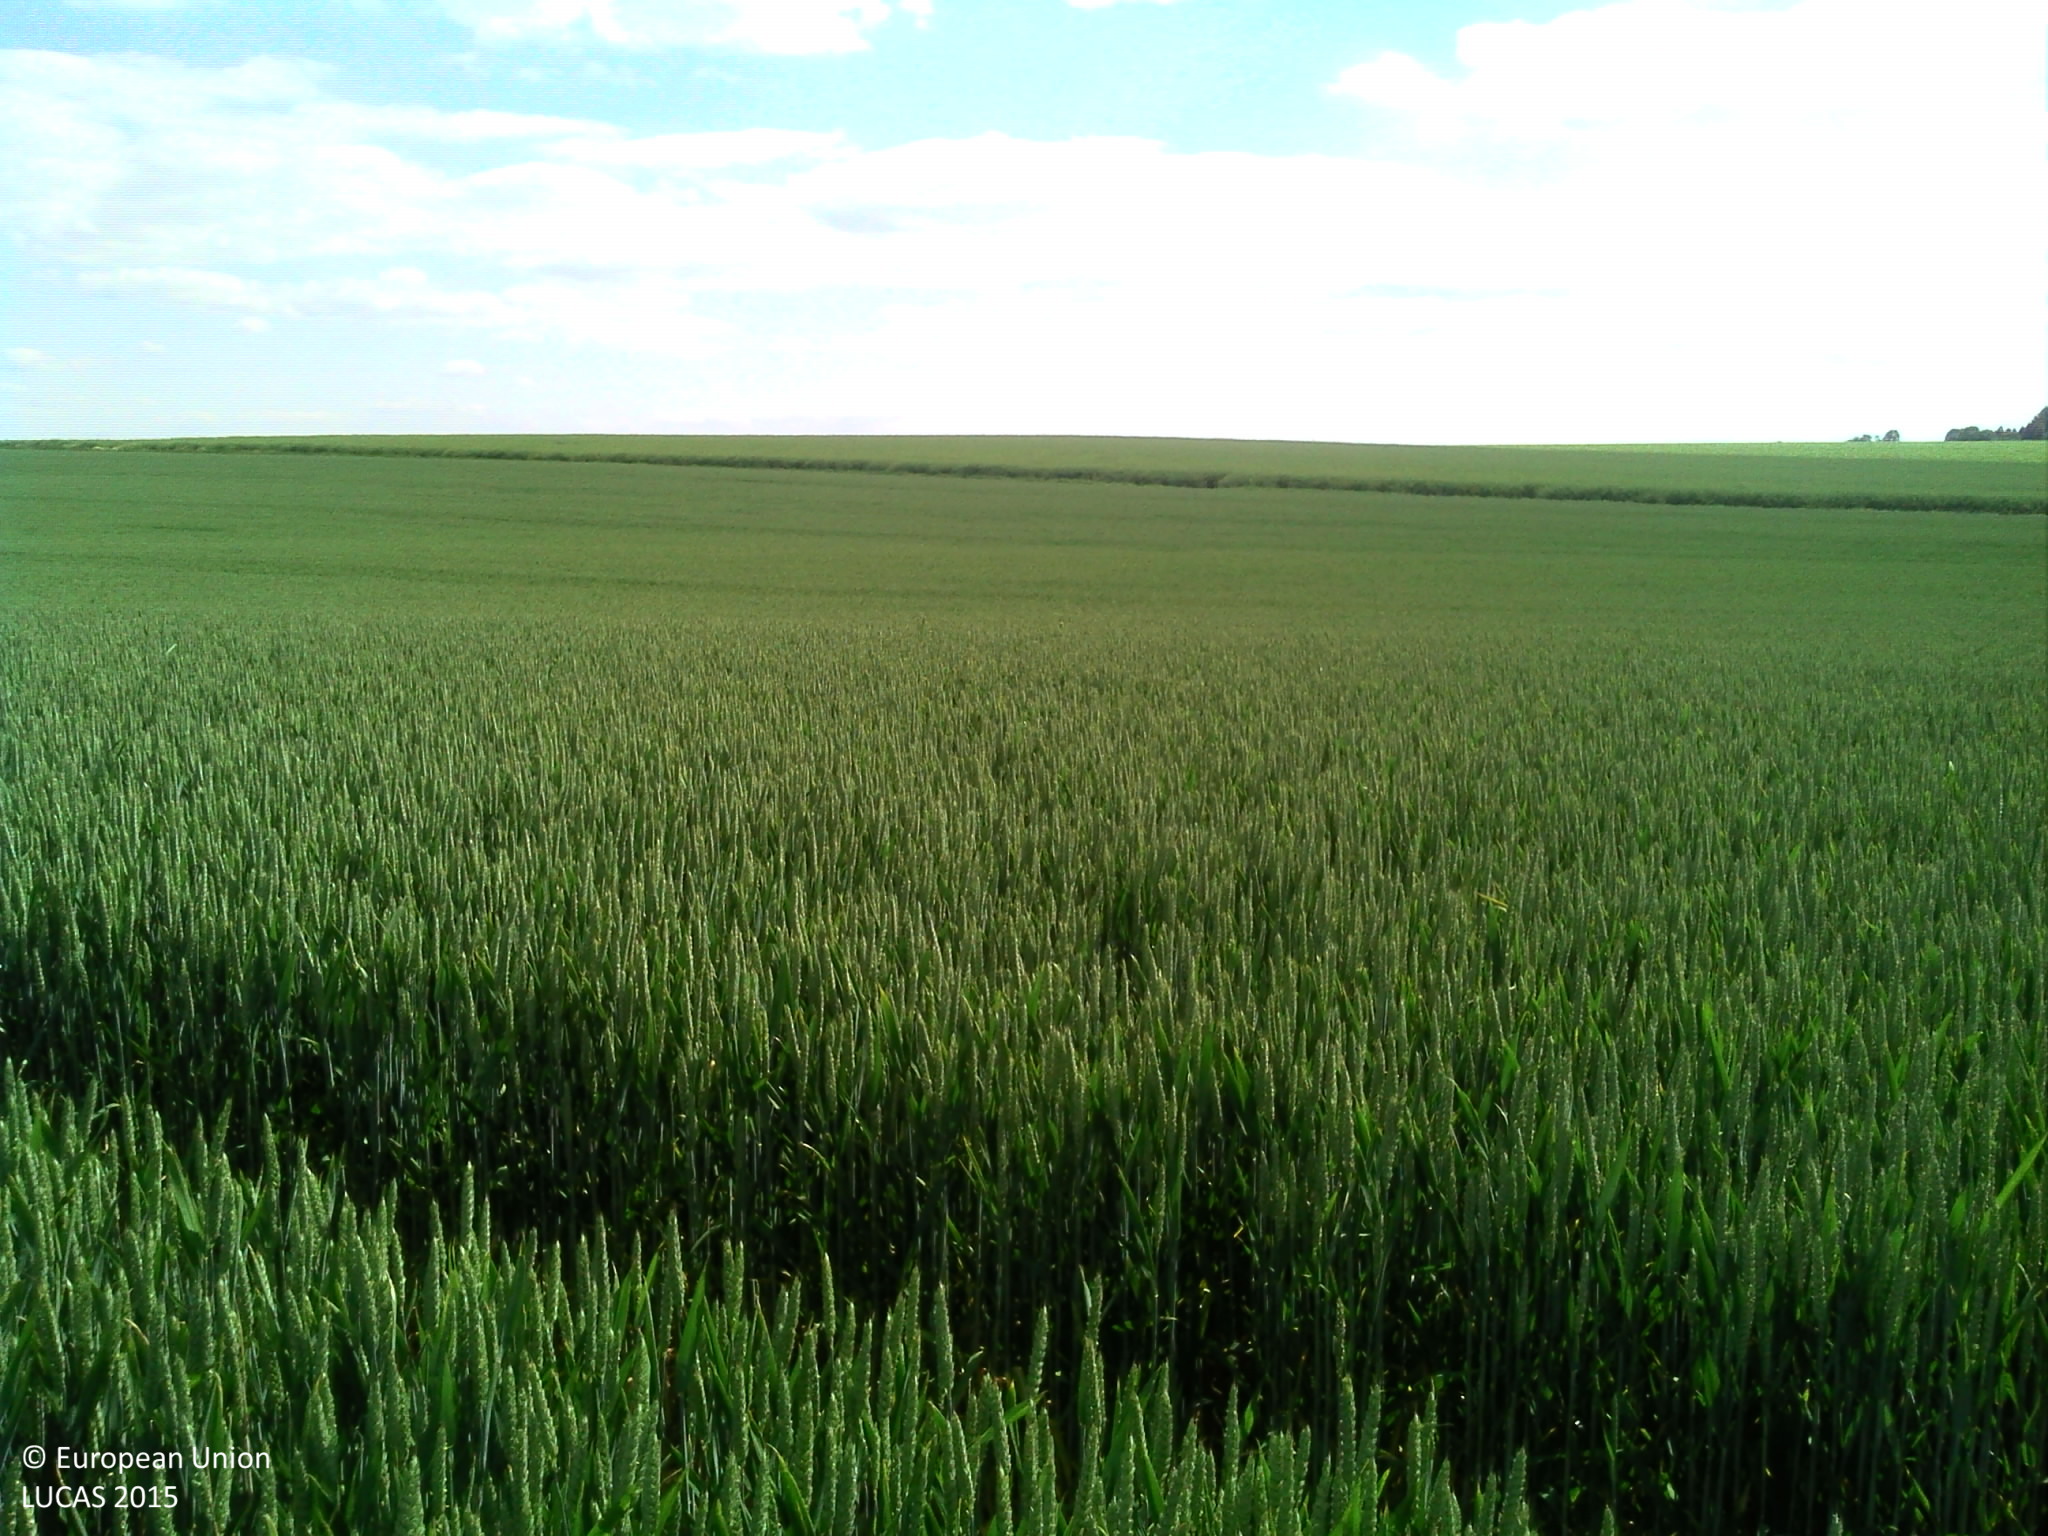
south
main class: Cropland
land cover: Common wheat
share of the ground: > 75 %
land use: Agriculture (excluding fallow land and kitchen gardens)
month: June
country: FR
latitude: 49.7564
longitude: 4.0119
